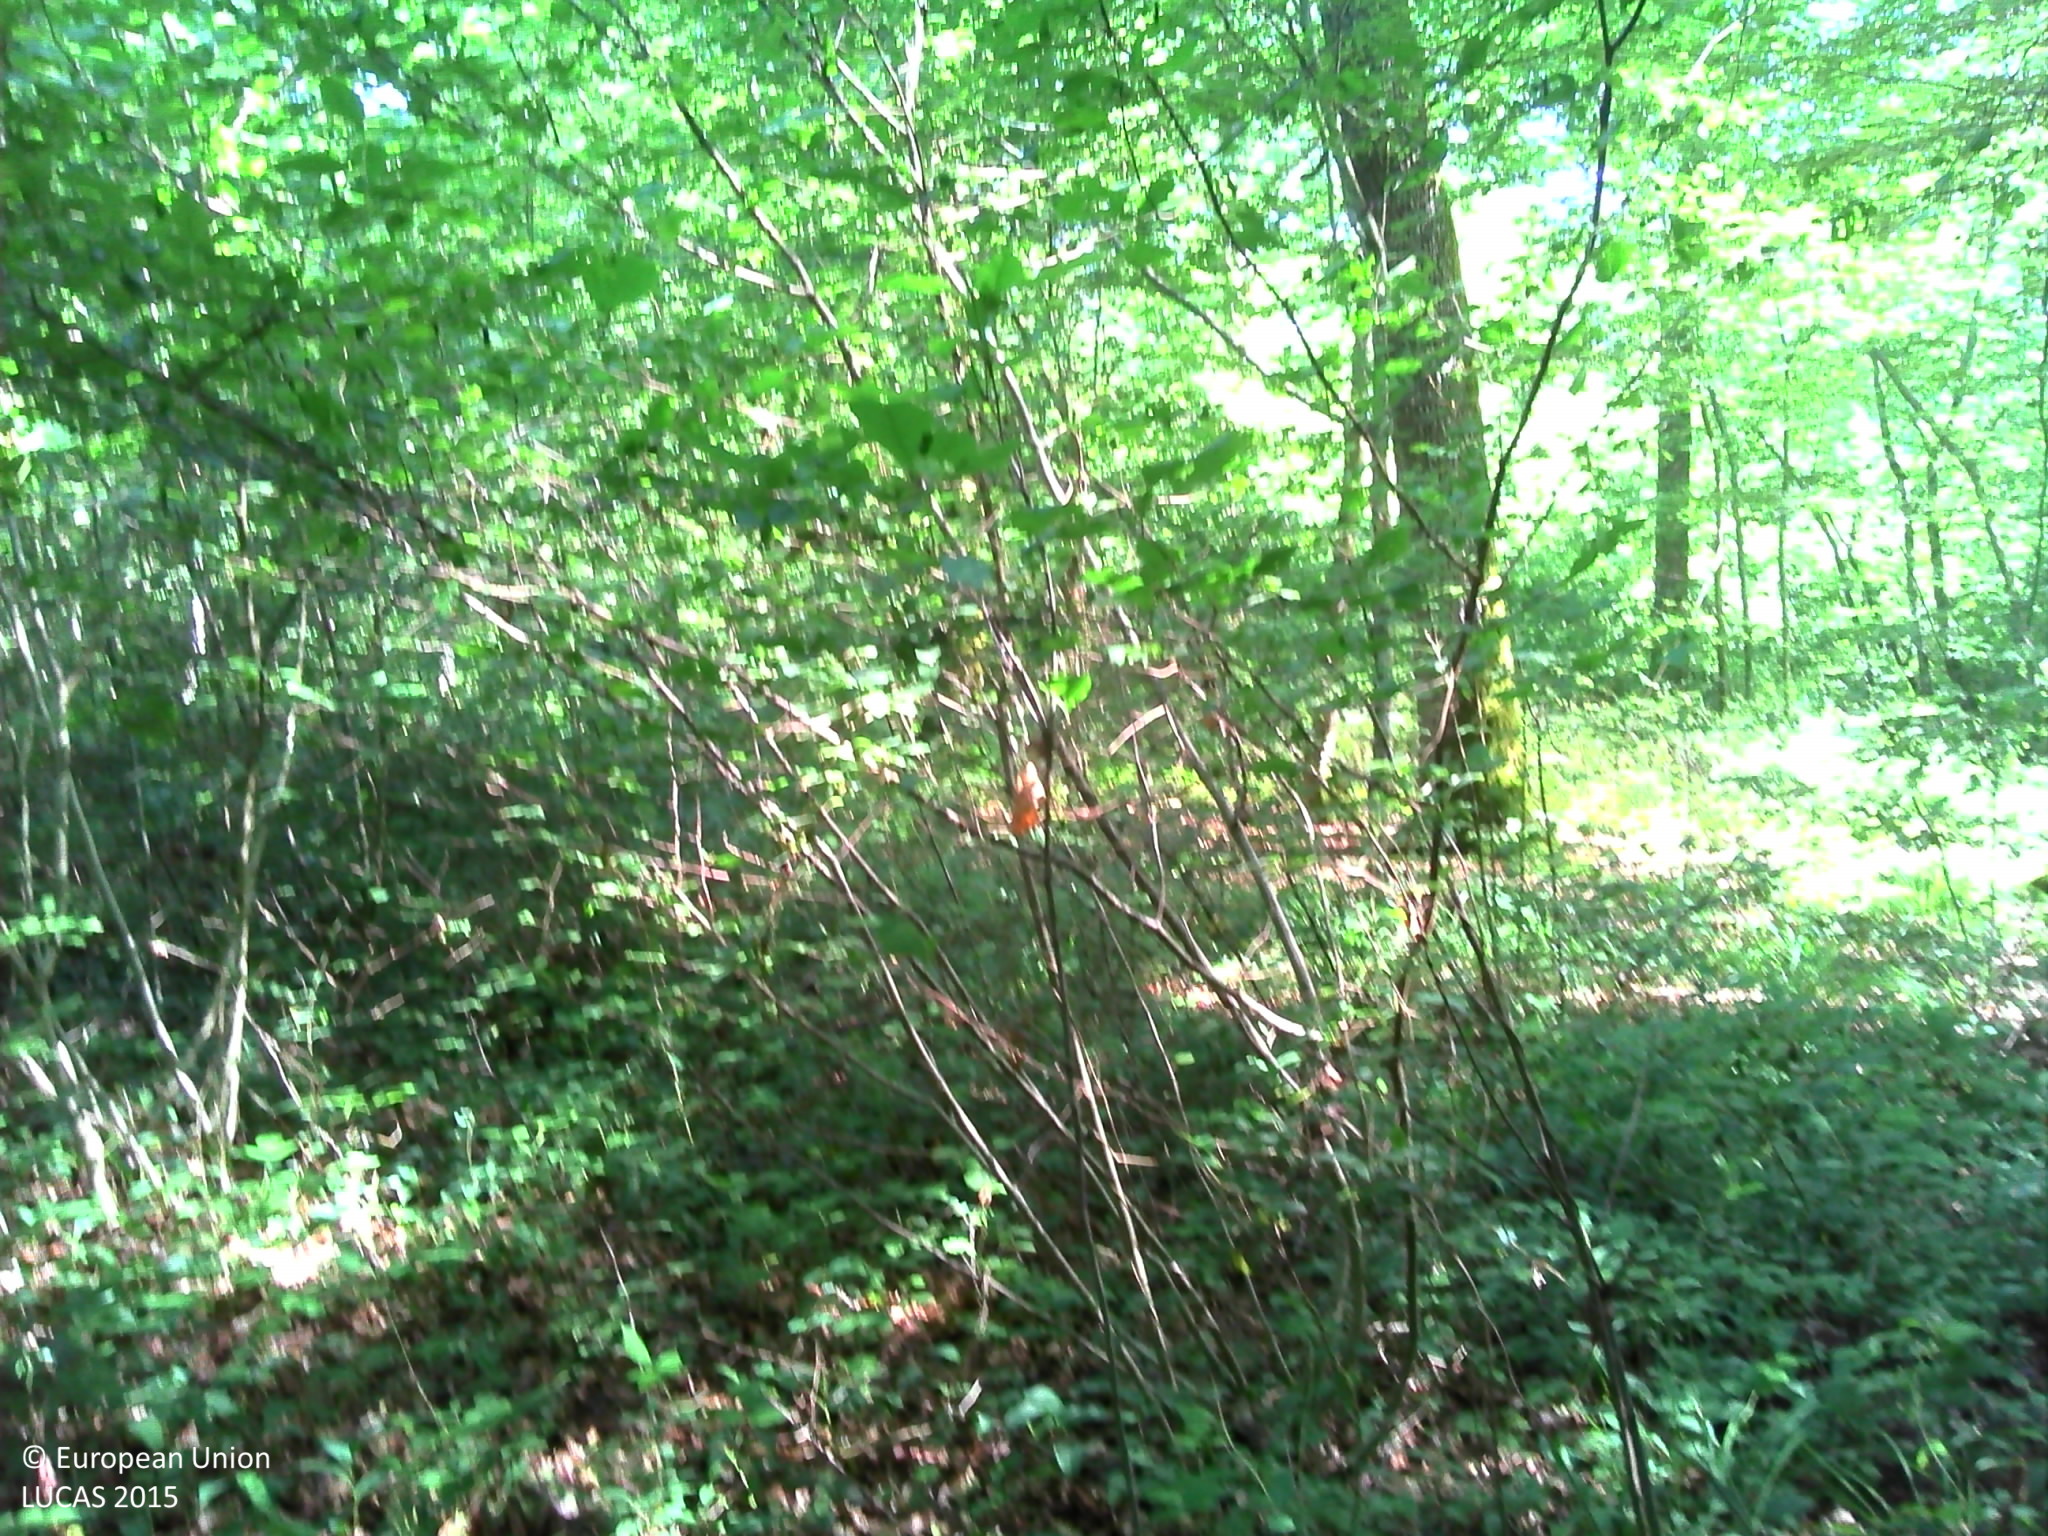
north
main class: Woodland
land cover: Broadleaved woodland
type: mesophytic deciduous forest
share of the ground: > 75 %
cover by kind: broadleaved forest trees 90 %, shrubs 5 %, lichens and mosses 5 %
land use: Forestry
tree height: > 5 m
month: June
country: FR
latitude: 46.9182
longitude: 5.3664
